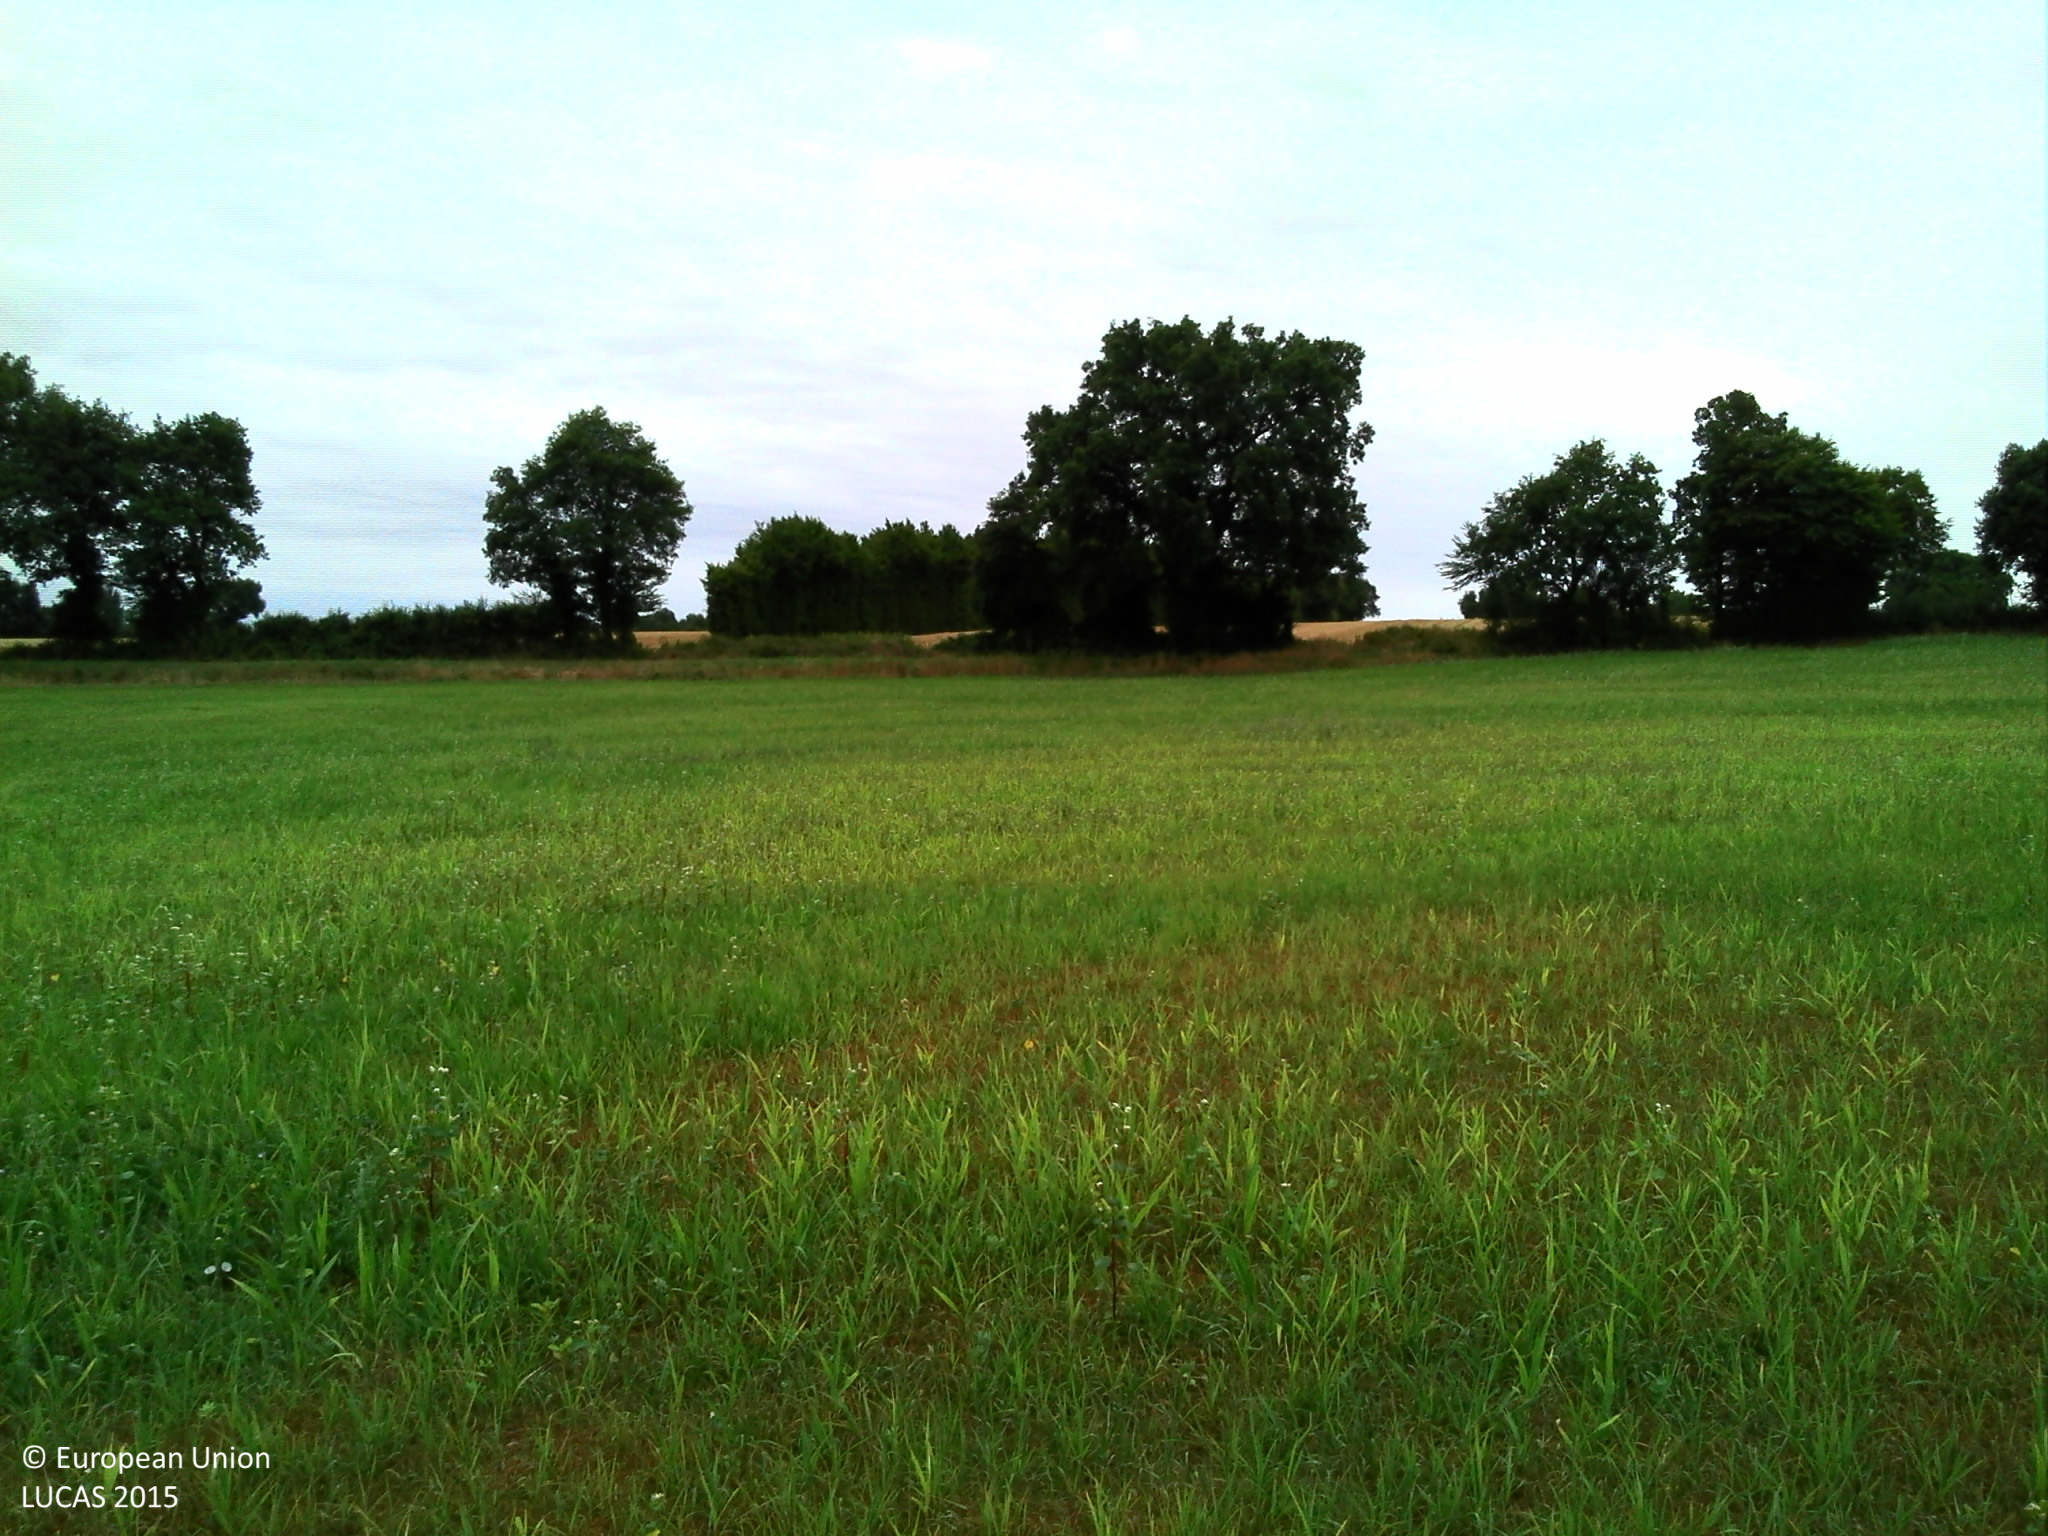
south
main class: Grassland
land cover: Grassland without tree/shrub cover
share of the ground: > 75 %
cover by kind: herbaceous plants 100 %
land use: Agriculture (excluding fallow land and kitchen gardens)
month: July
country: FR
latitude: 46.3569
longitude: 0.6400
